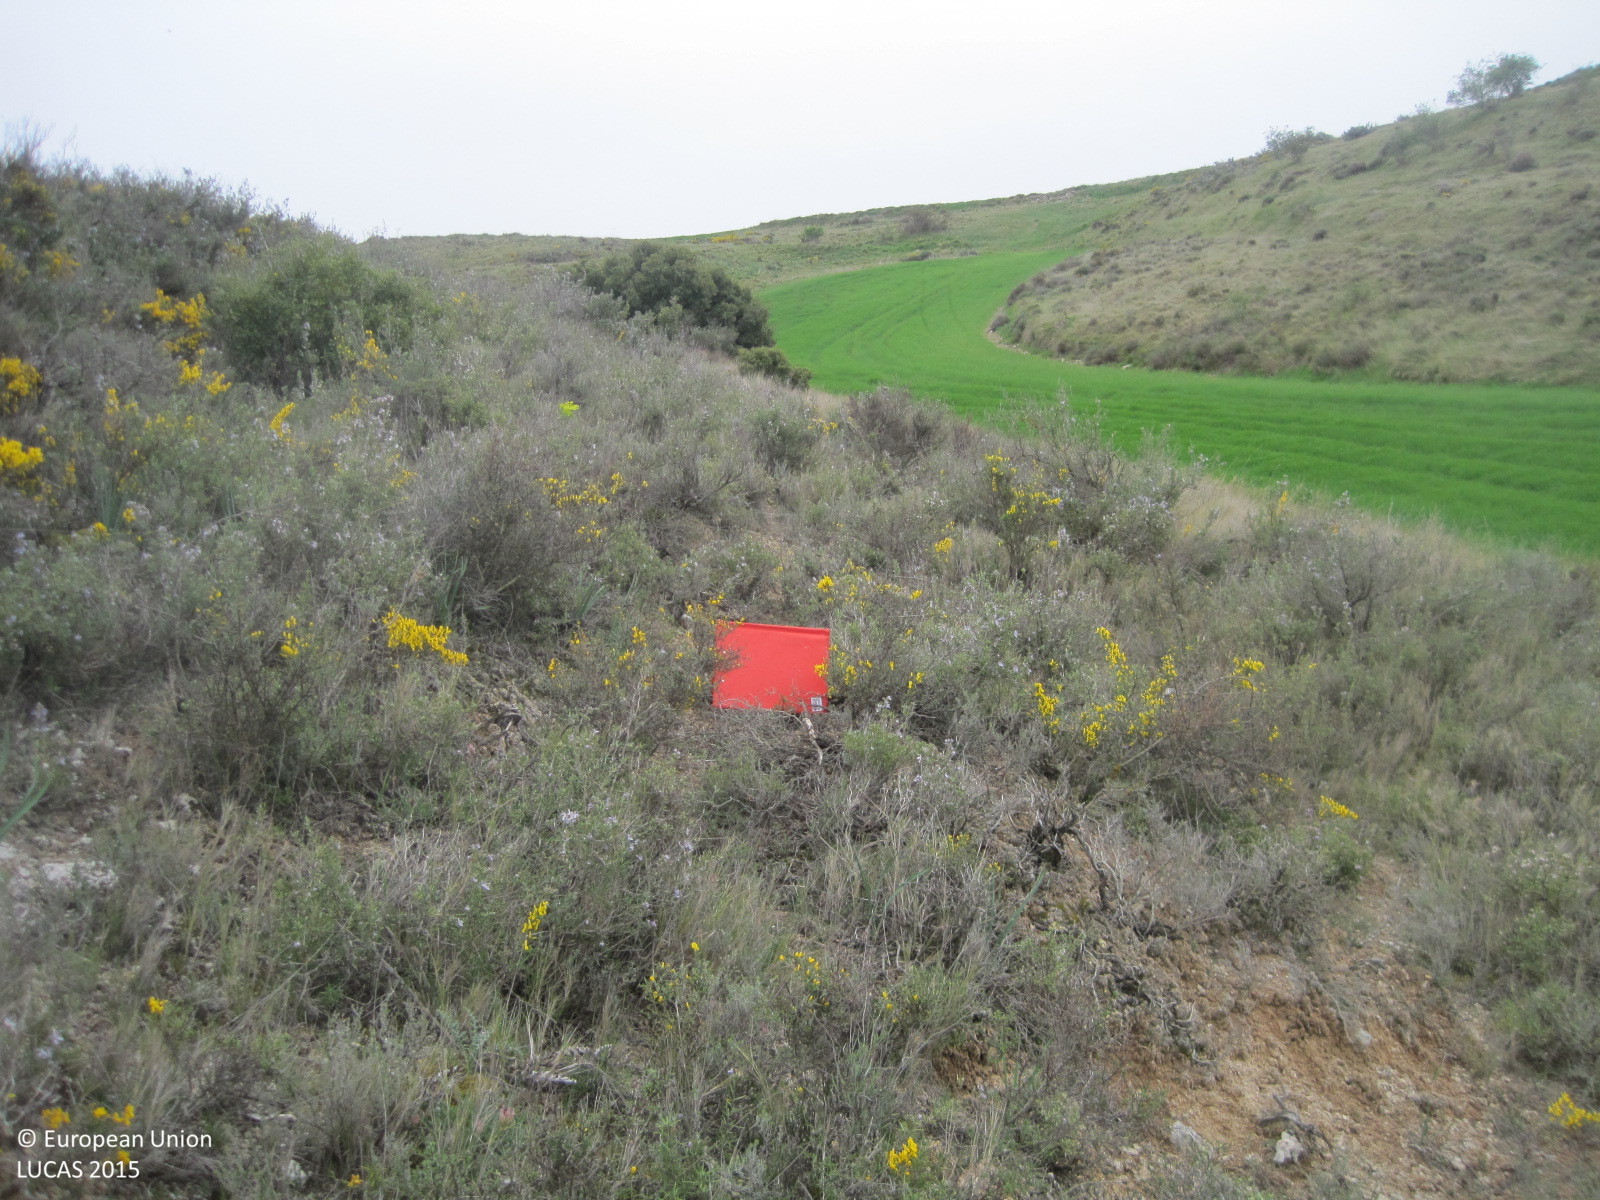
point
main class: Shrubland
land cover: Shrubland without tree cover
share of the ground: > 75 %
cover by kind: shrubs 60 %, unconsolidated bare surface 40 %
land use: Semi-natural and natural areas not in use
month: April
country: ES
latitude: 42.5183
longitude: -2.1777
